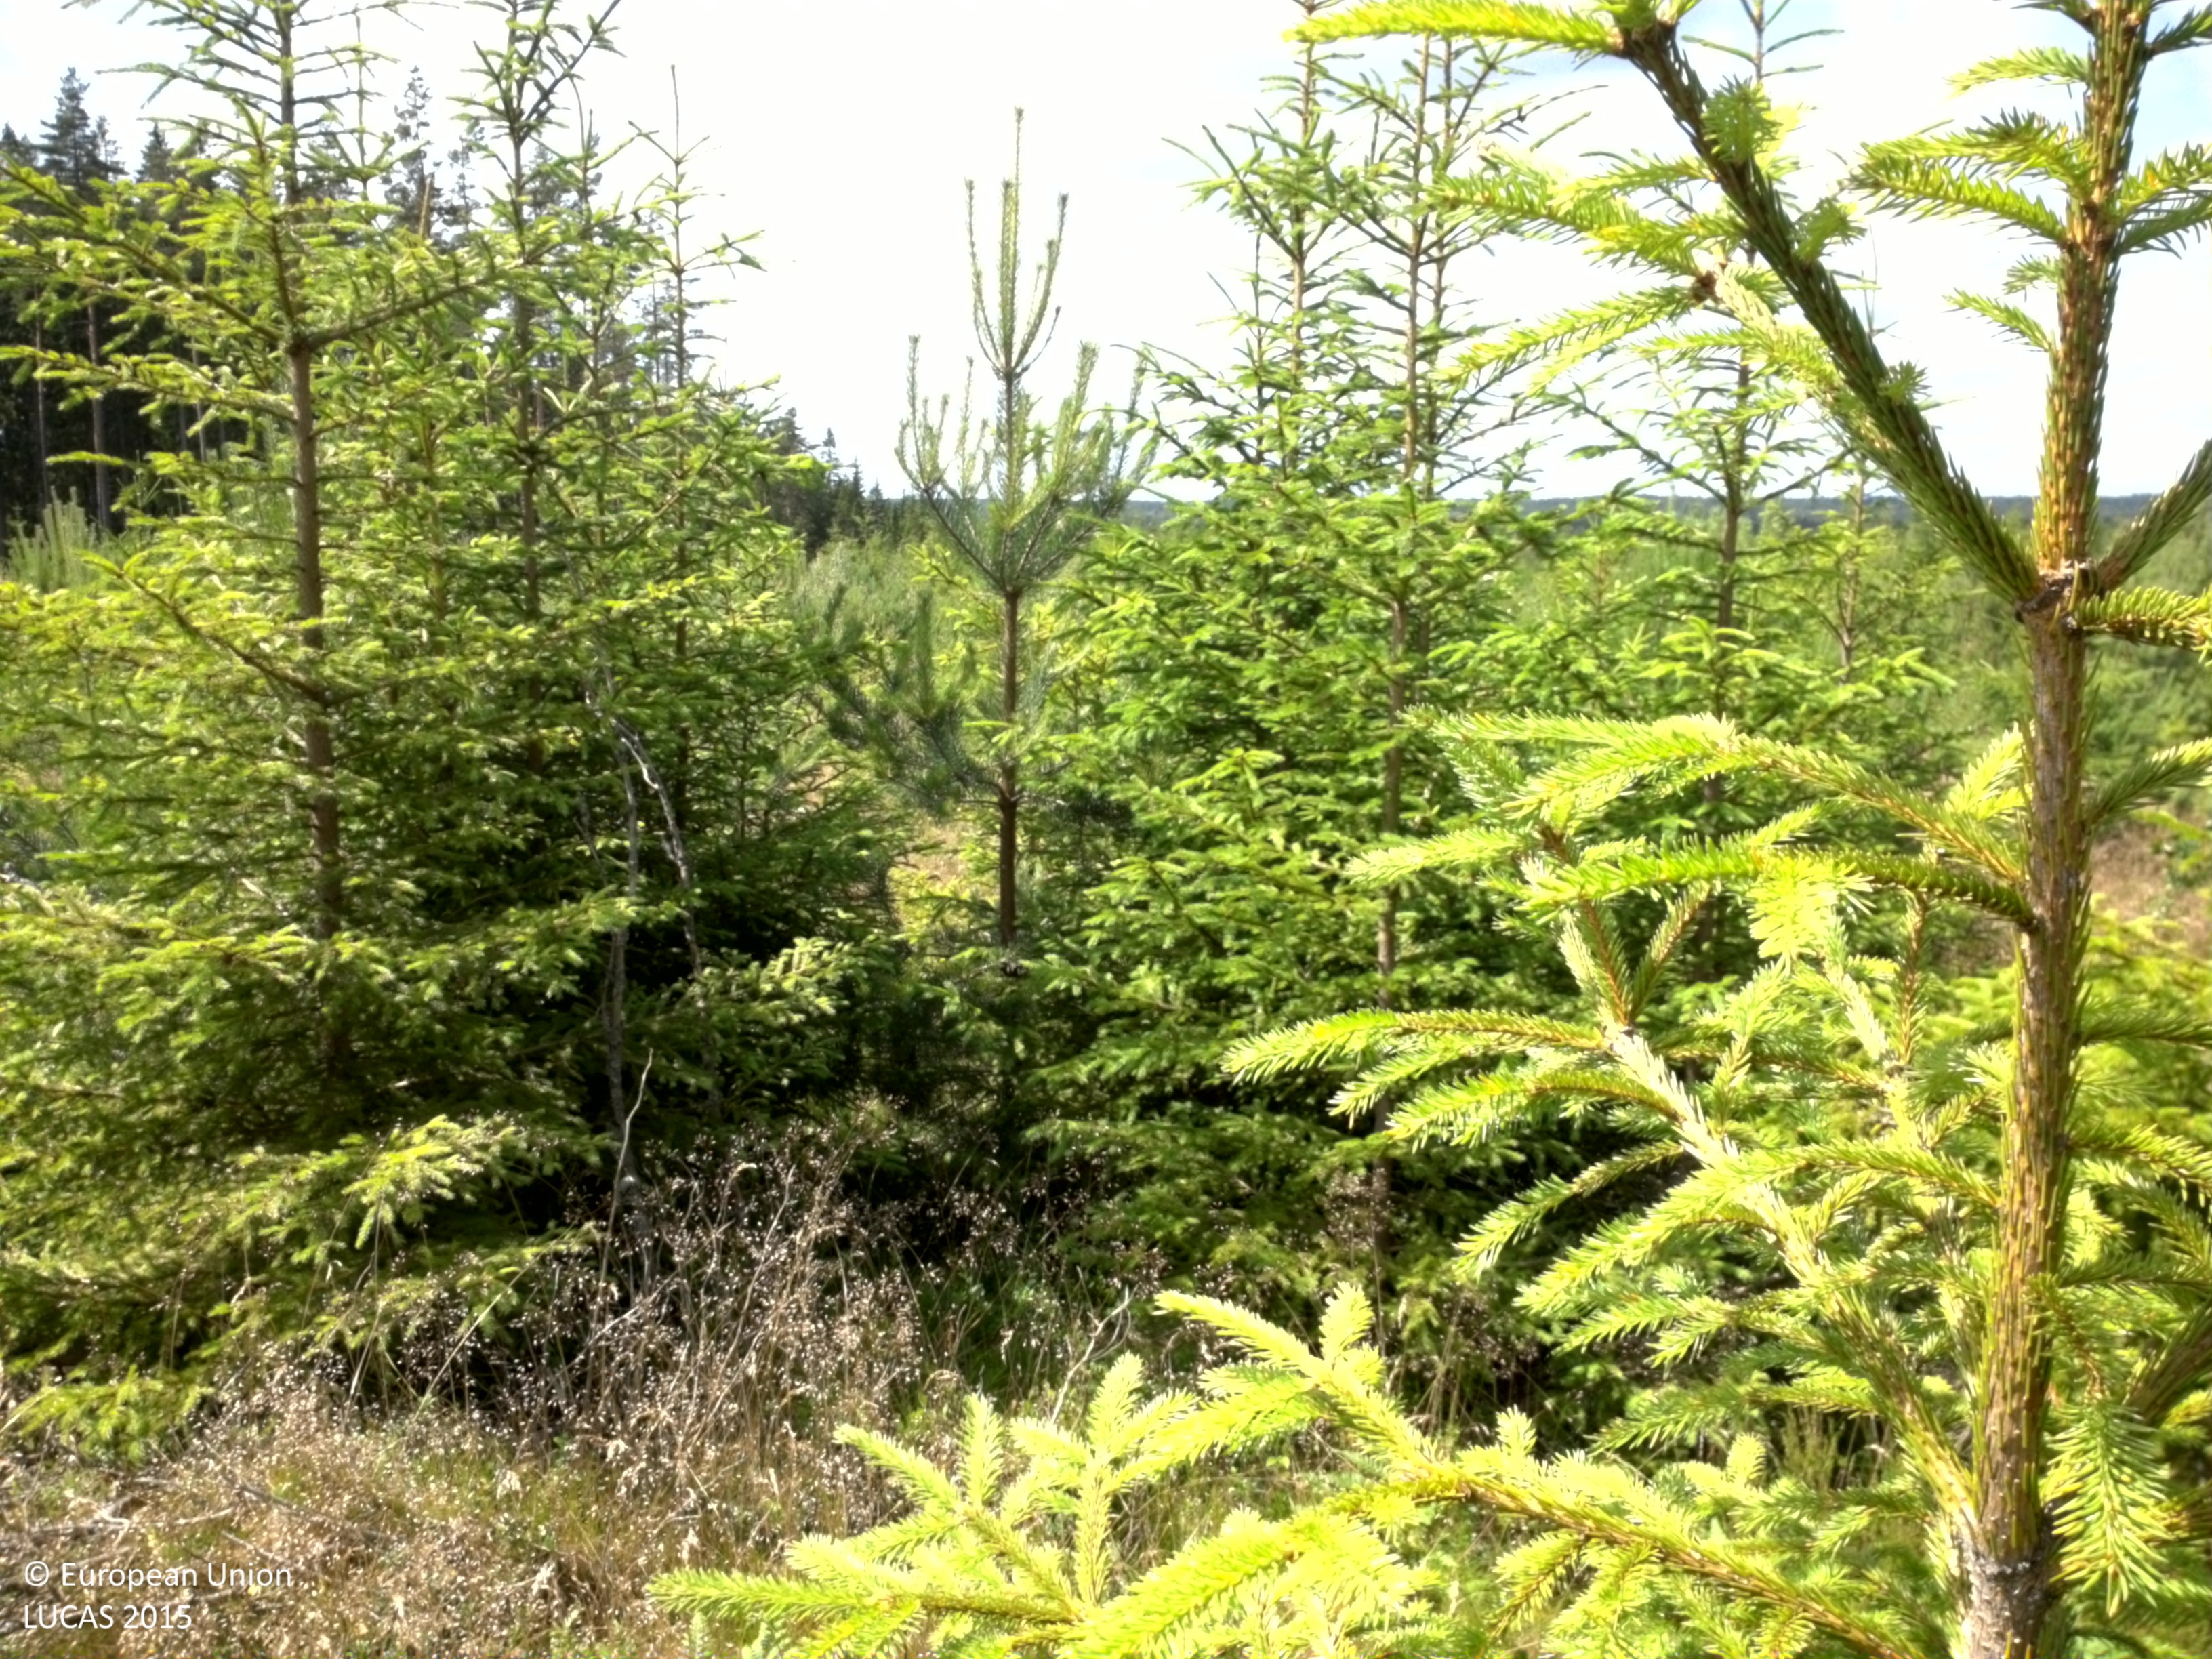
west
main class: Woodland
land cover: Other mixed woodland
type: boreal forest
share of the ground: 50 - 75 %
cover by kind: coniferous forest trees 40 %, broadleaved forest trees 20 %, herbaceous plants 20 %, shrubs 10 %, lichens and mosses 10 %
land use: Forestry
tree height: < 5 m
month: July
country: SE
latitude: 58.8633
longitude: 14.5527
